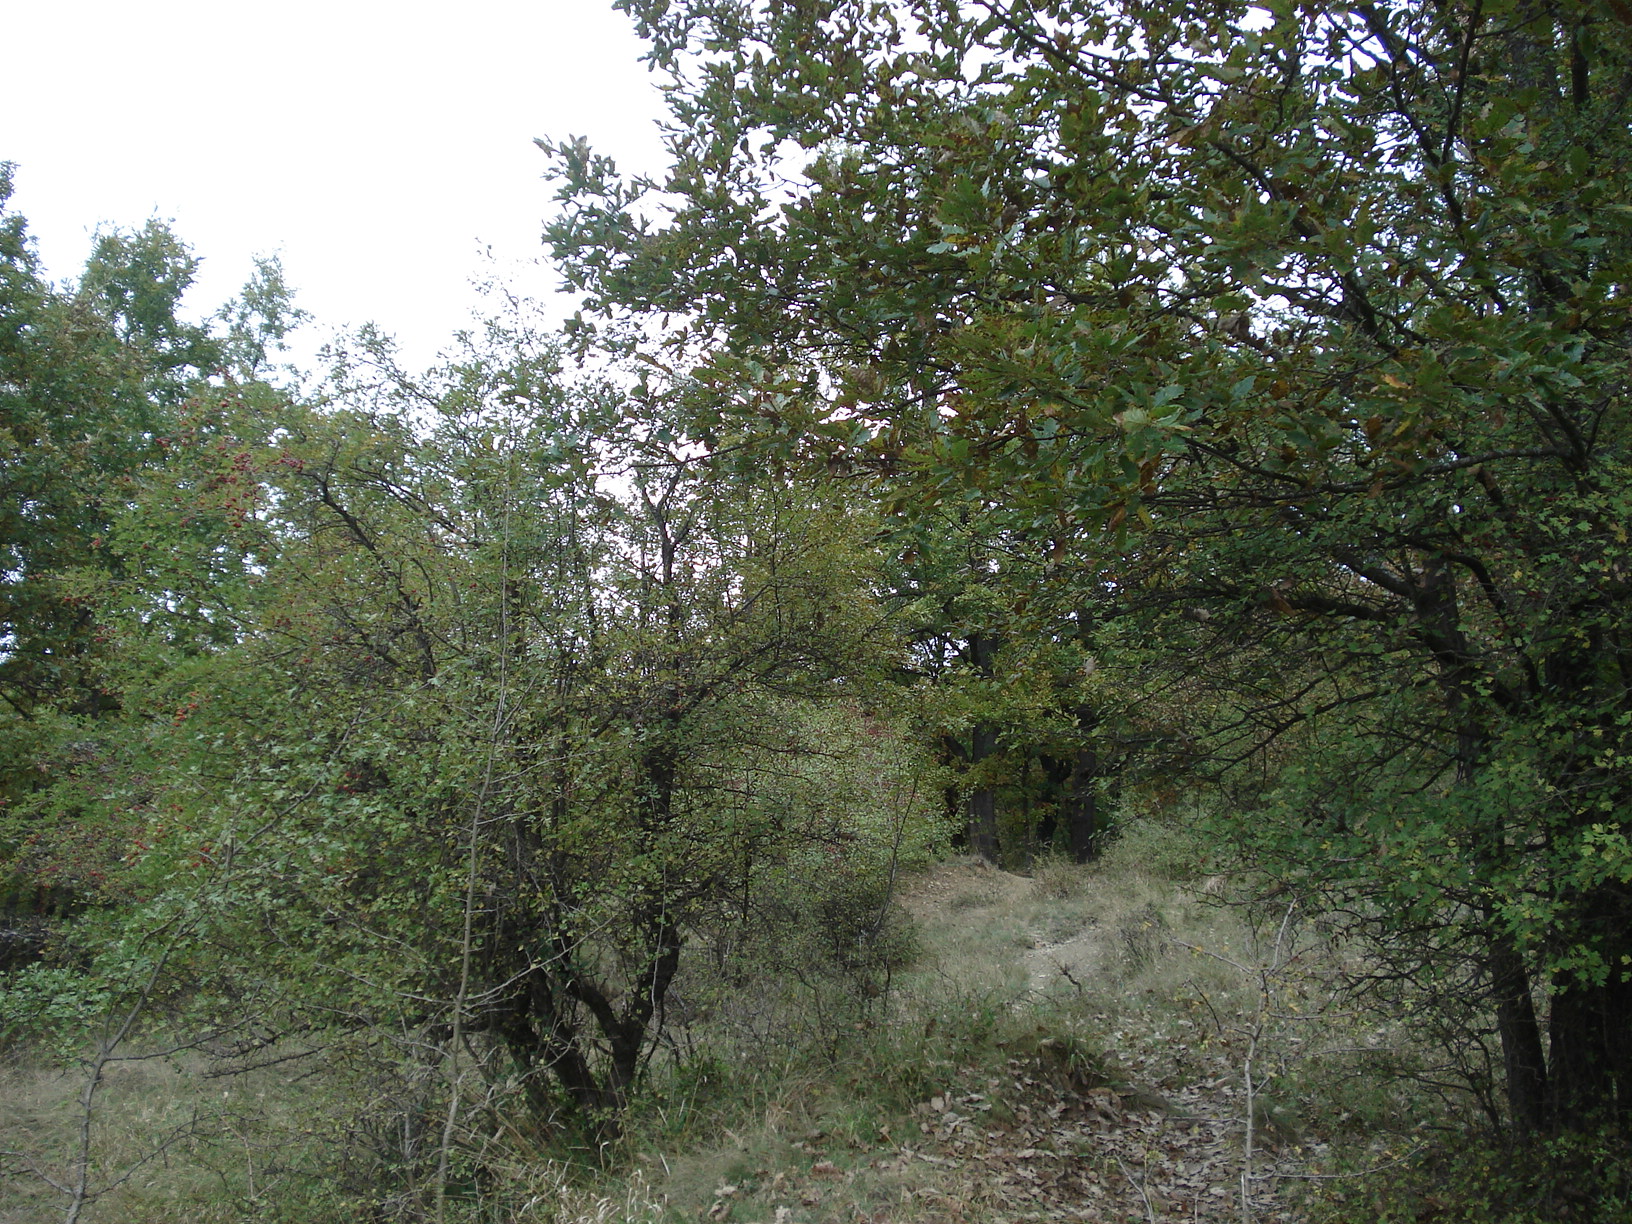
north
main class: Woodland
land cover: Broadleaved woodland
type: mesophytic deciduous forest
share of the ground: 50 - 75 %
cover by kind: broadleaved forest trees 60 %, shrubs 20 %, herbaceous plants 20 %
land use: Semi-natural and natural areas not in use
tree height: > 5 m
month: October
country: BG
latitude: 42.9273
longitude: 25.9266
